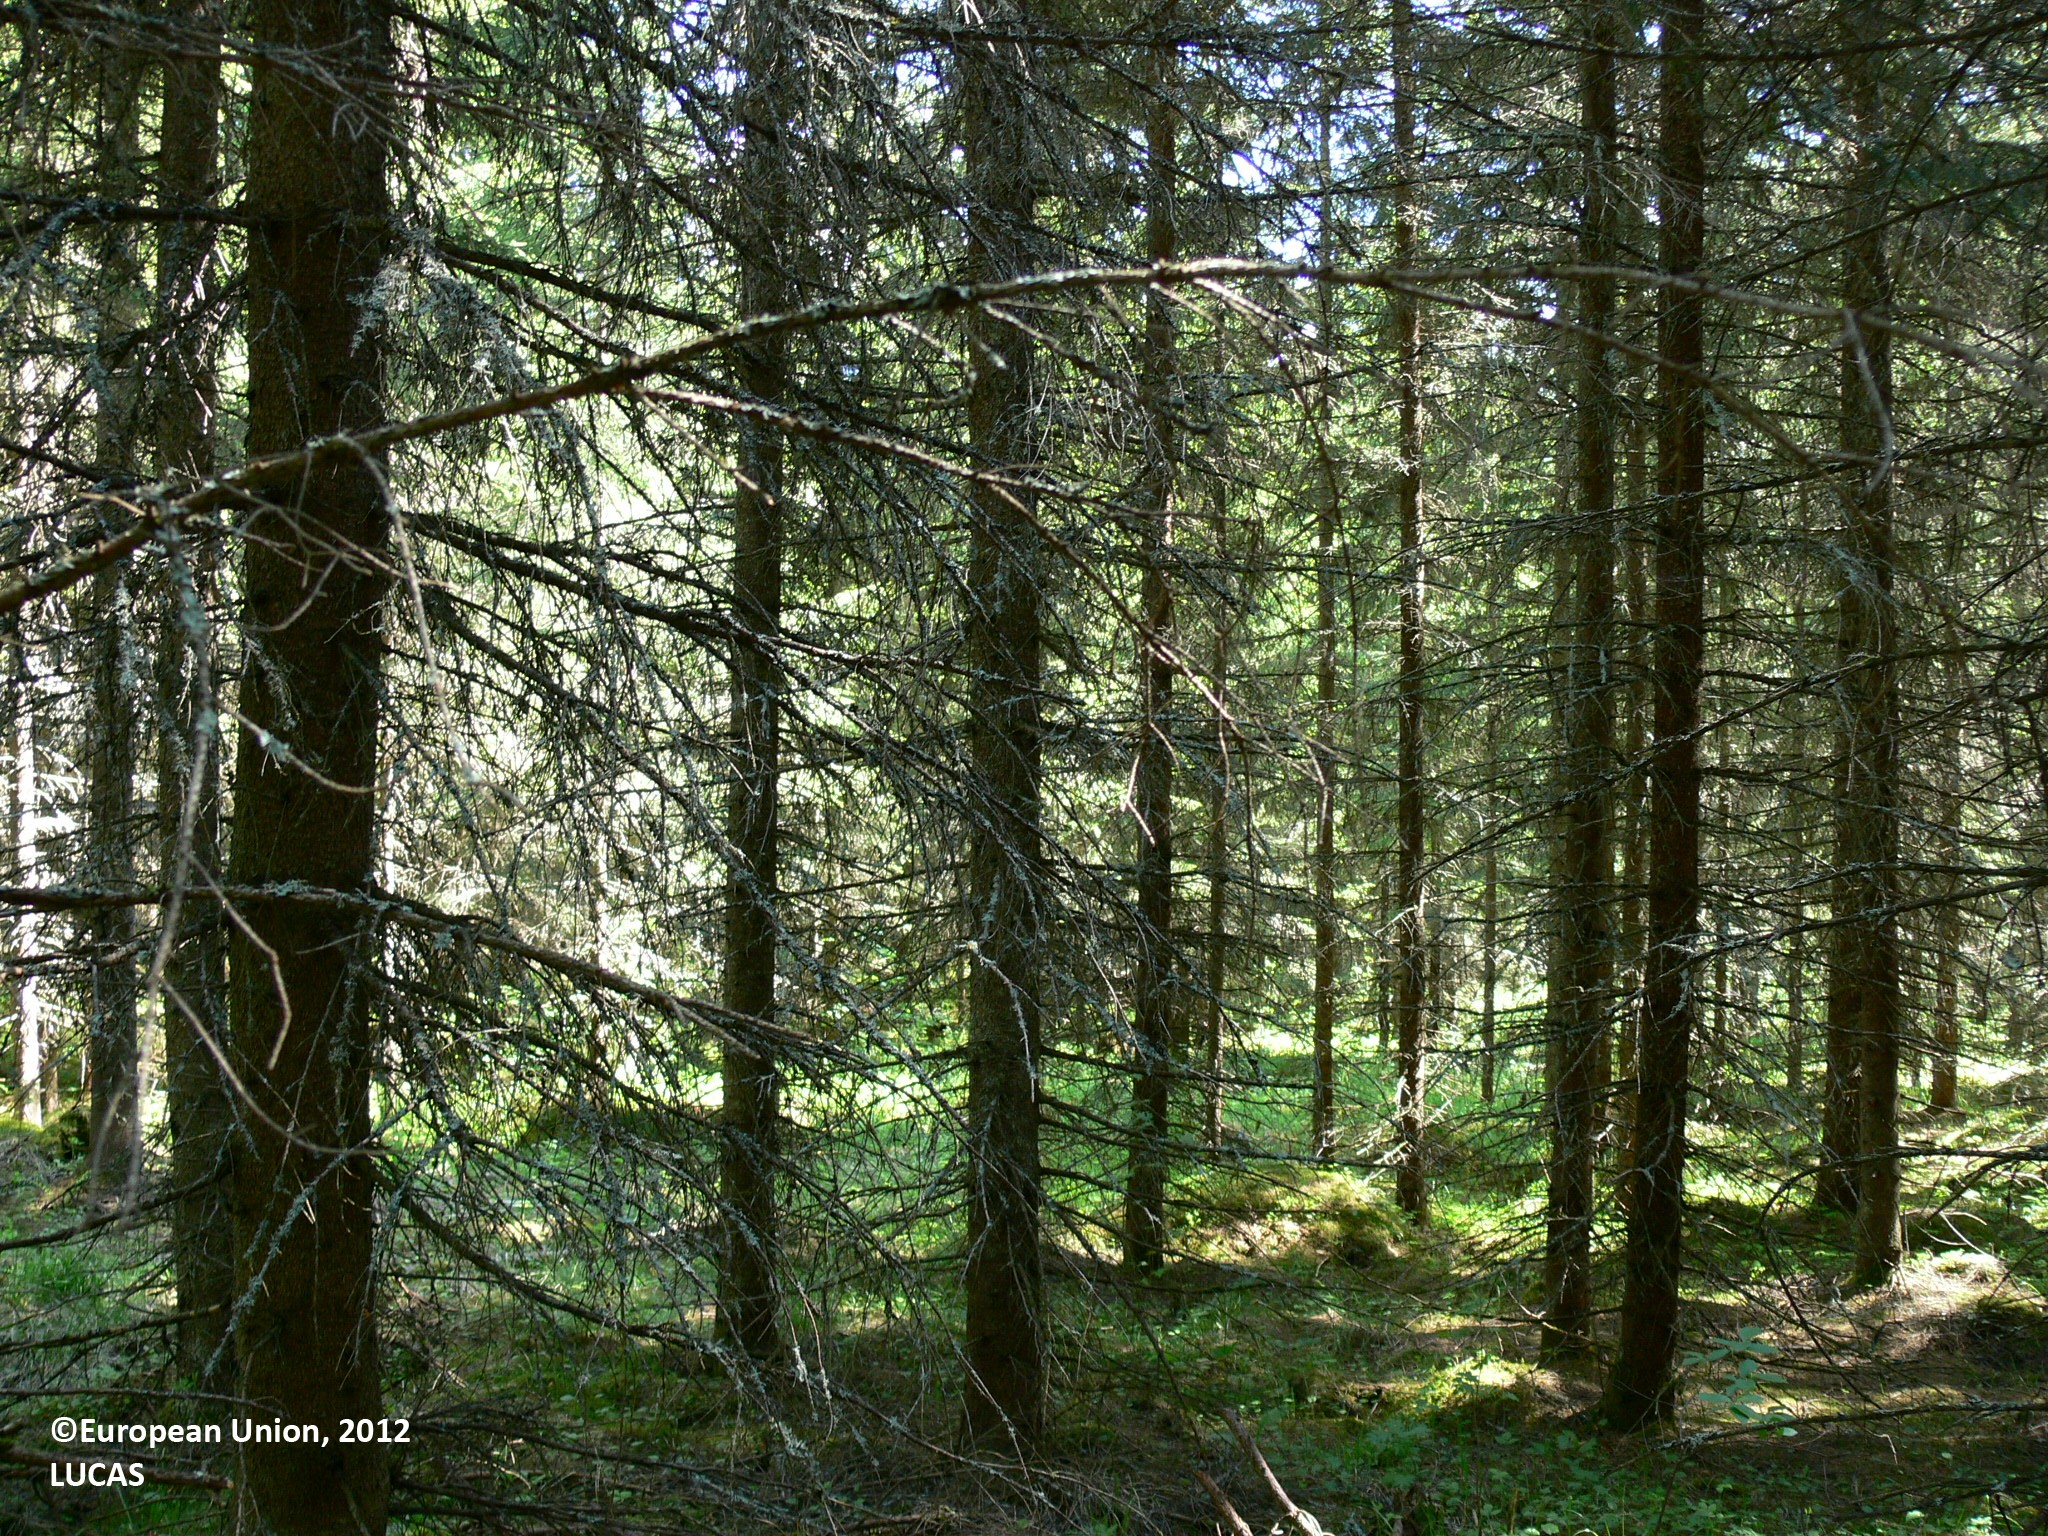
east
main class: Woodland
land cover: Spruce dominated coniferous woodland
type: boreal forest
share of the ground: > 75 %
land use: Forestry
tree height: > 5 m
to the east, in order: Spruce dominated coniferous woodland; Grass margins; Paved roads, cycling and walking lanes; Grass margins; Electric lines; Grass margins; Other mixed woodland; Inland water bodies
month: June
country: FI
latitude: 62.5798
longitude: 30.3832
